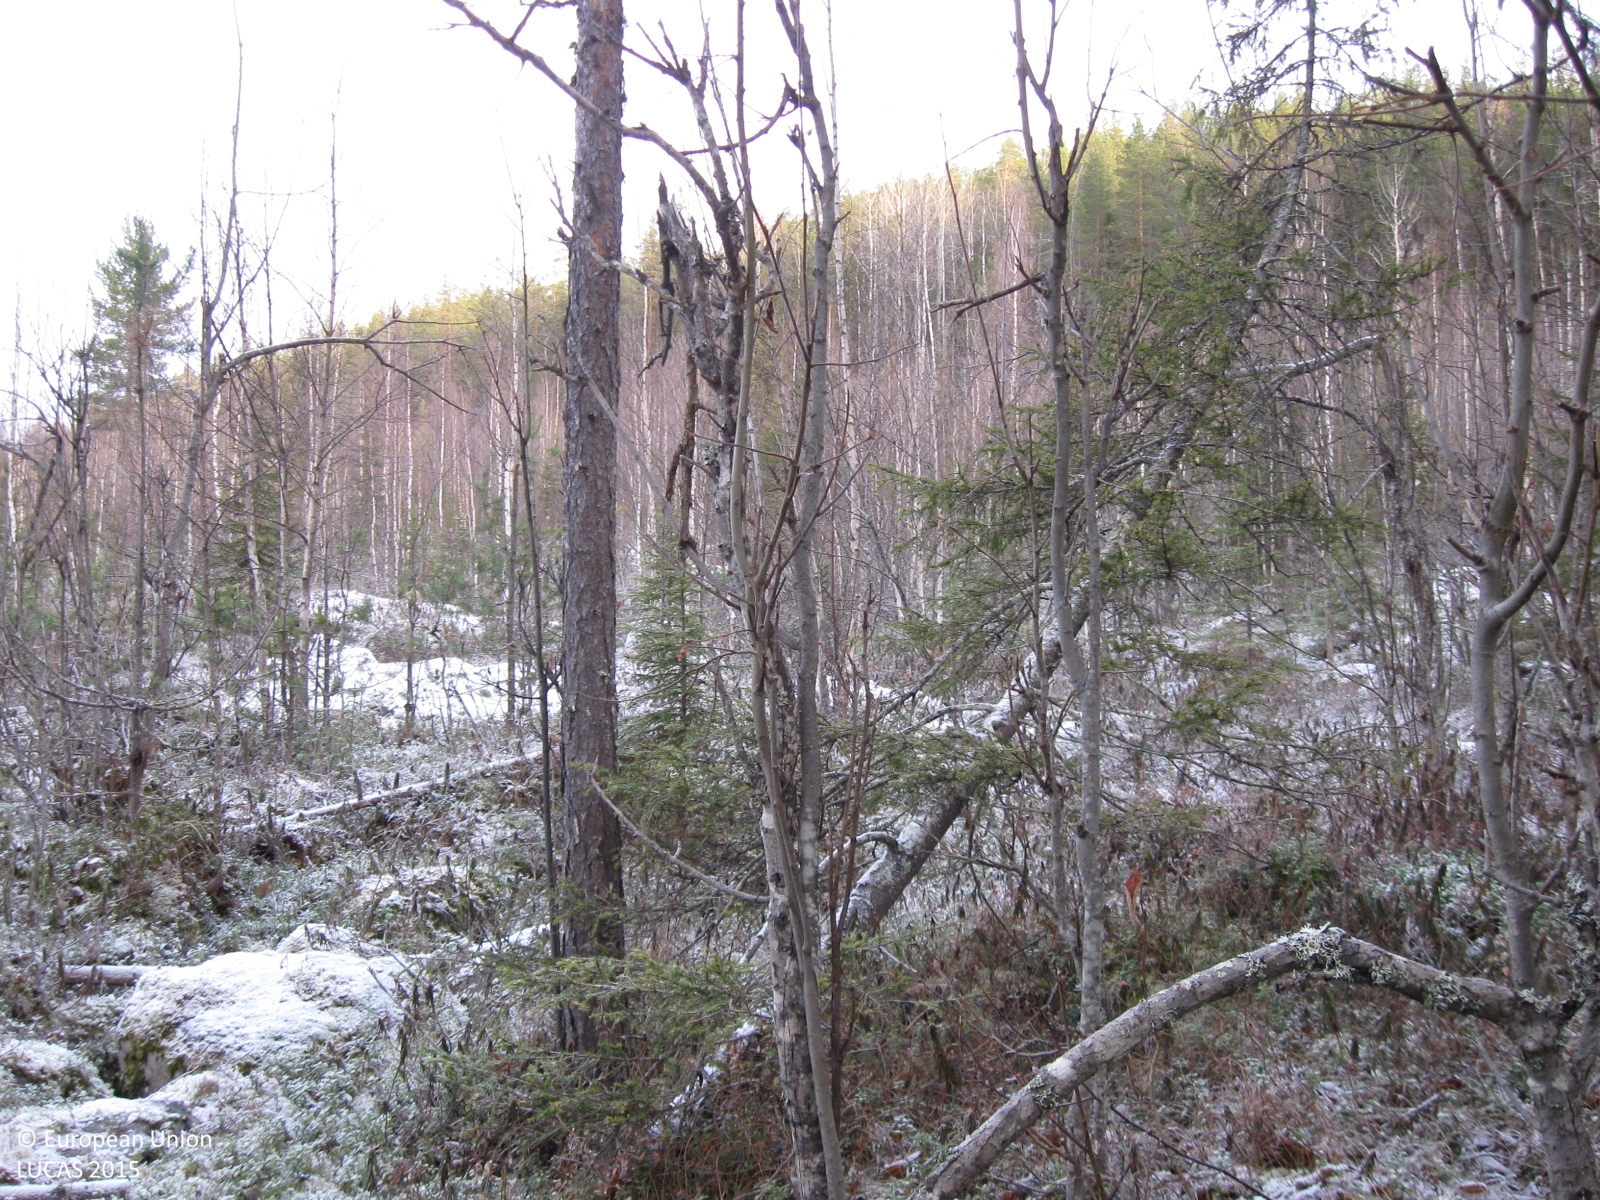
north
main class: Woodland
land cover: Pine dominated mixed woodland
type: boreal forest
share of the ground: 50 - 75 %
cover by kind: coniferous forest trees 45 %, broadleaved forest trees 25 %, unconsolidated bare surface 15 %, shrubs 5 %, herbaceous plants 5 %, lichens and mosses 5 %
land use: Forestry
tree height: > 5 m
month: October
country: SE
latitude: 66.2213
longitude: 21.6357
